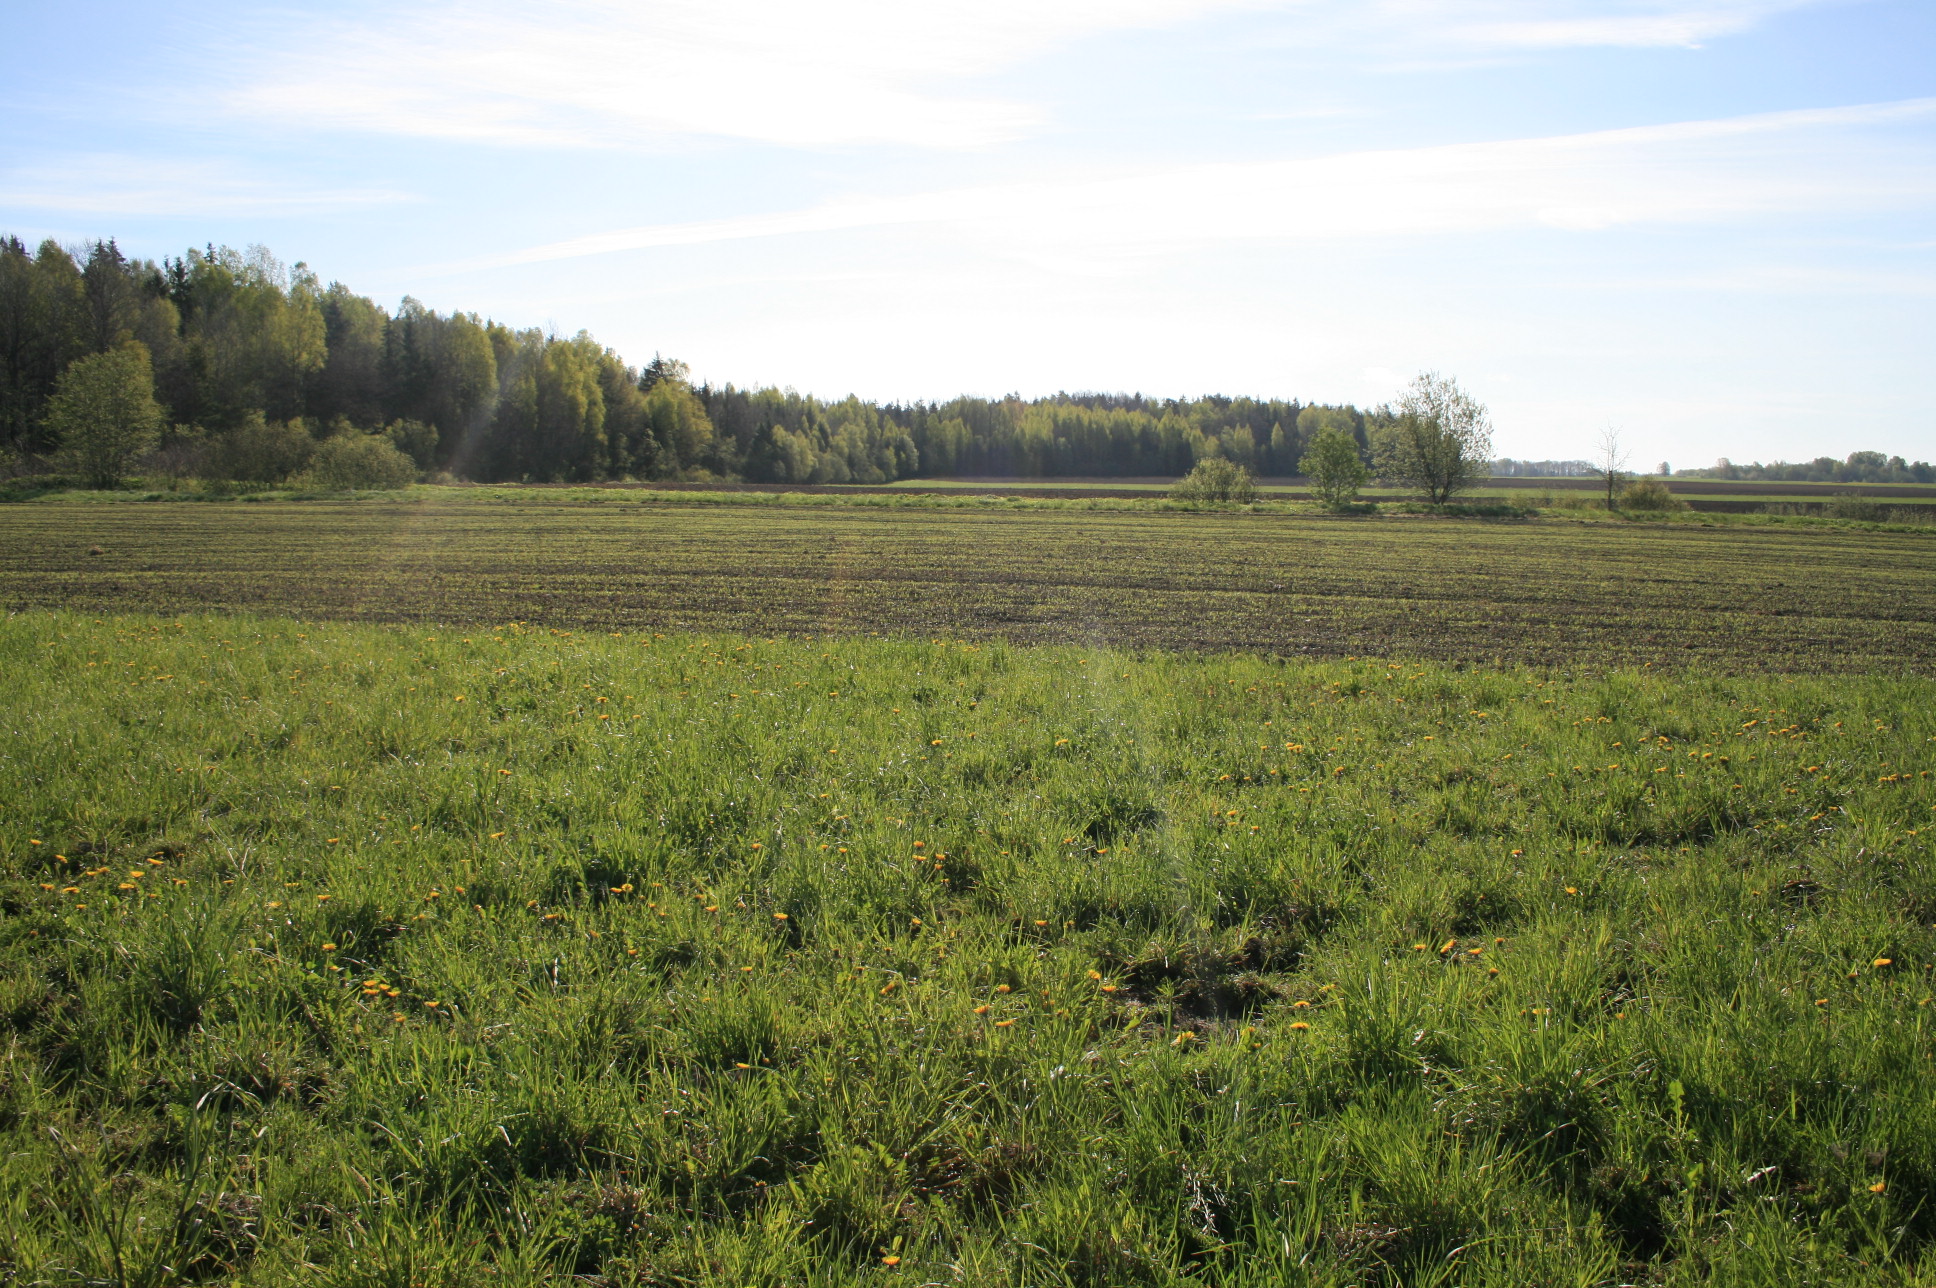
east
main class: Grassland
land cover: Grassland without tree/shrub cover
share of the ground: > 75 %
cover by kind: herbaceous plants 95 %, lichens and mosses 5 %
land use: Agriculture (excluding fallow land and kitchen gardens)
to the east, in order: Grassland without tree/shrub cover; Common wheat; Grassland without tree/shrub cover; Ditches and canals; Grassland without tree/shrub cover; Common wheat; Shruby margins; Ditches and canals; Spruce dominated mixed woodland
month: May
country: LT
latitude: 56.1045
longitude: 21.5076
